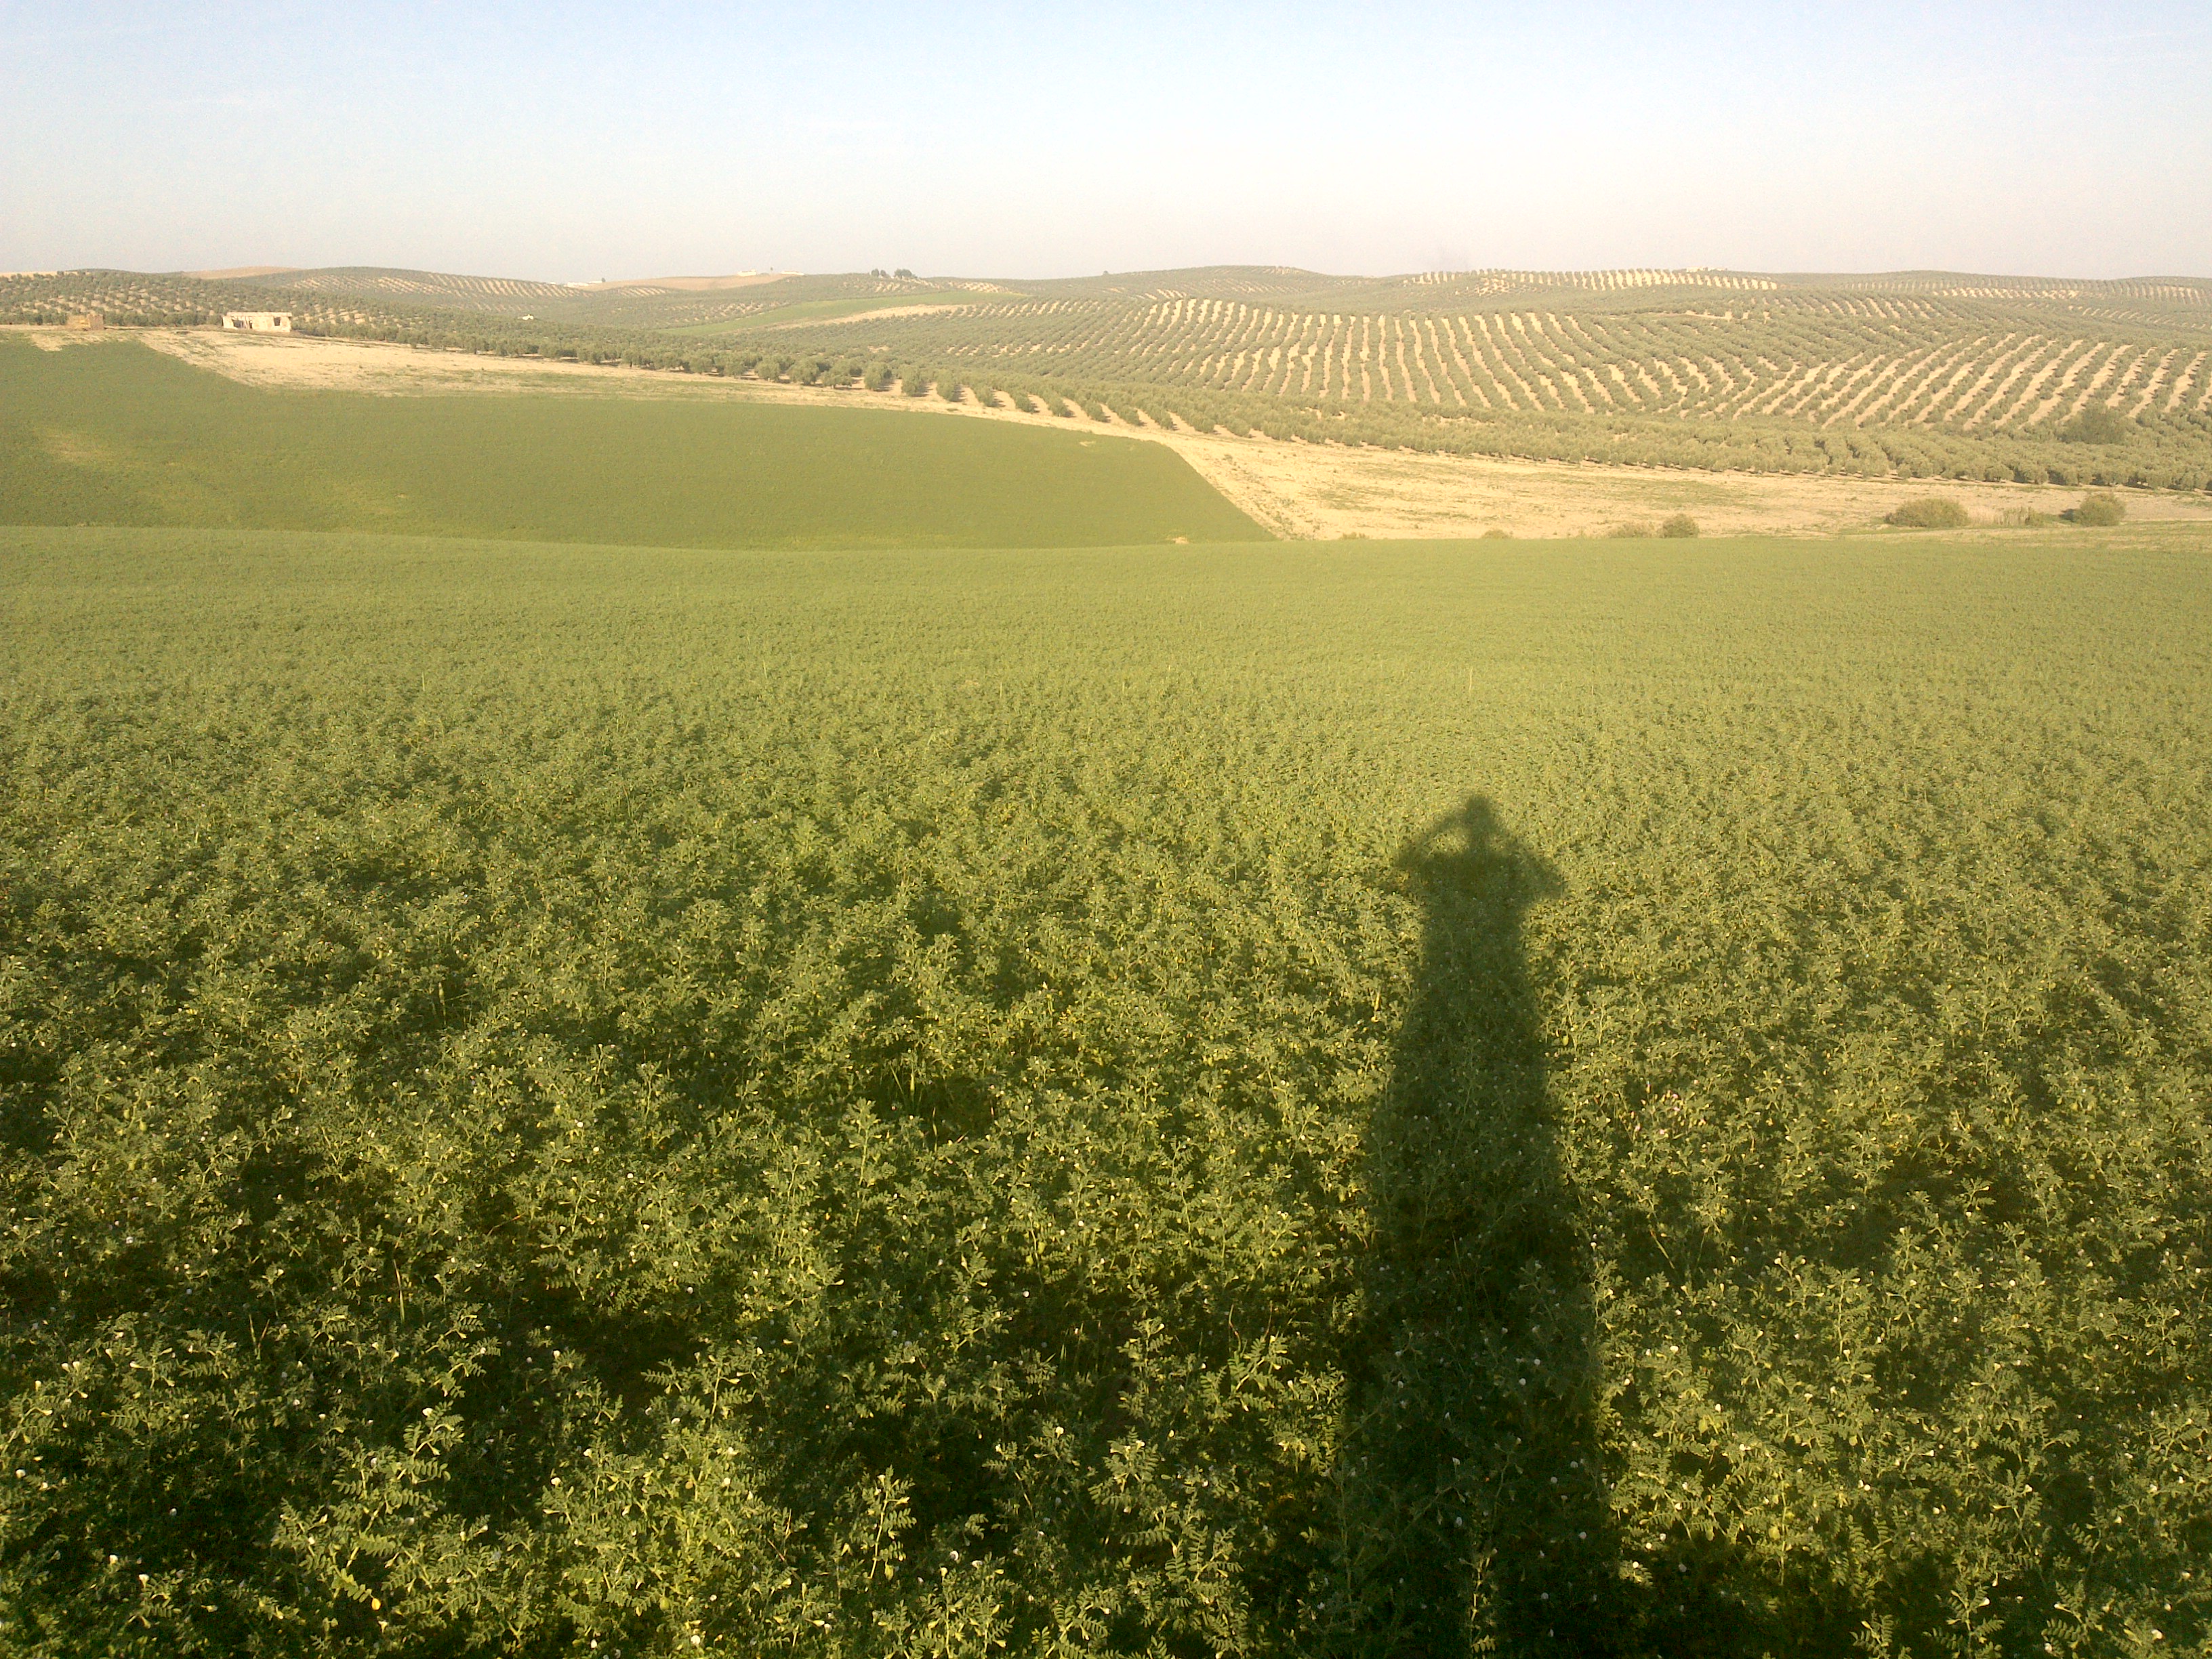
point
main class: Cropland
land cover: Dry pulses
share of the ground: > 75 %
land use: Agriculture (excluding fallow land and kitchen gardens)
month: May
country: ES
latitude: 37.8858
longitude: -4.4619
